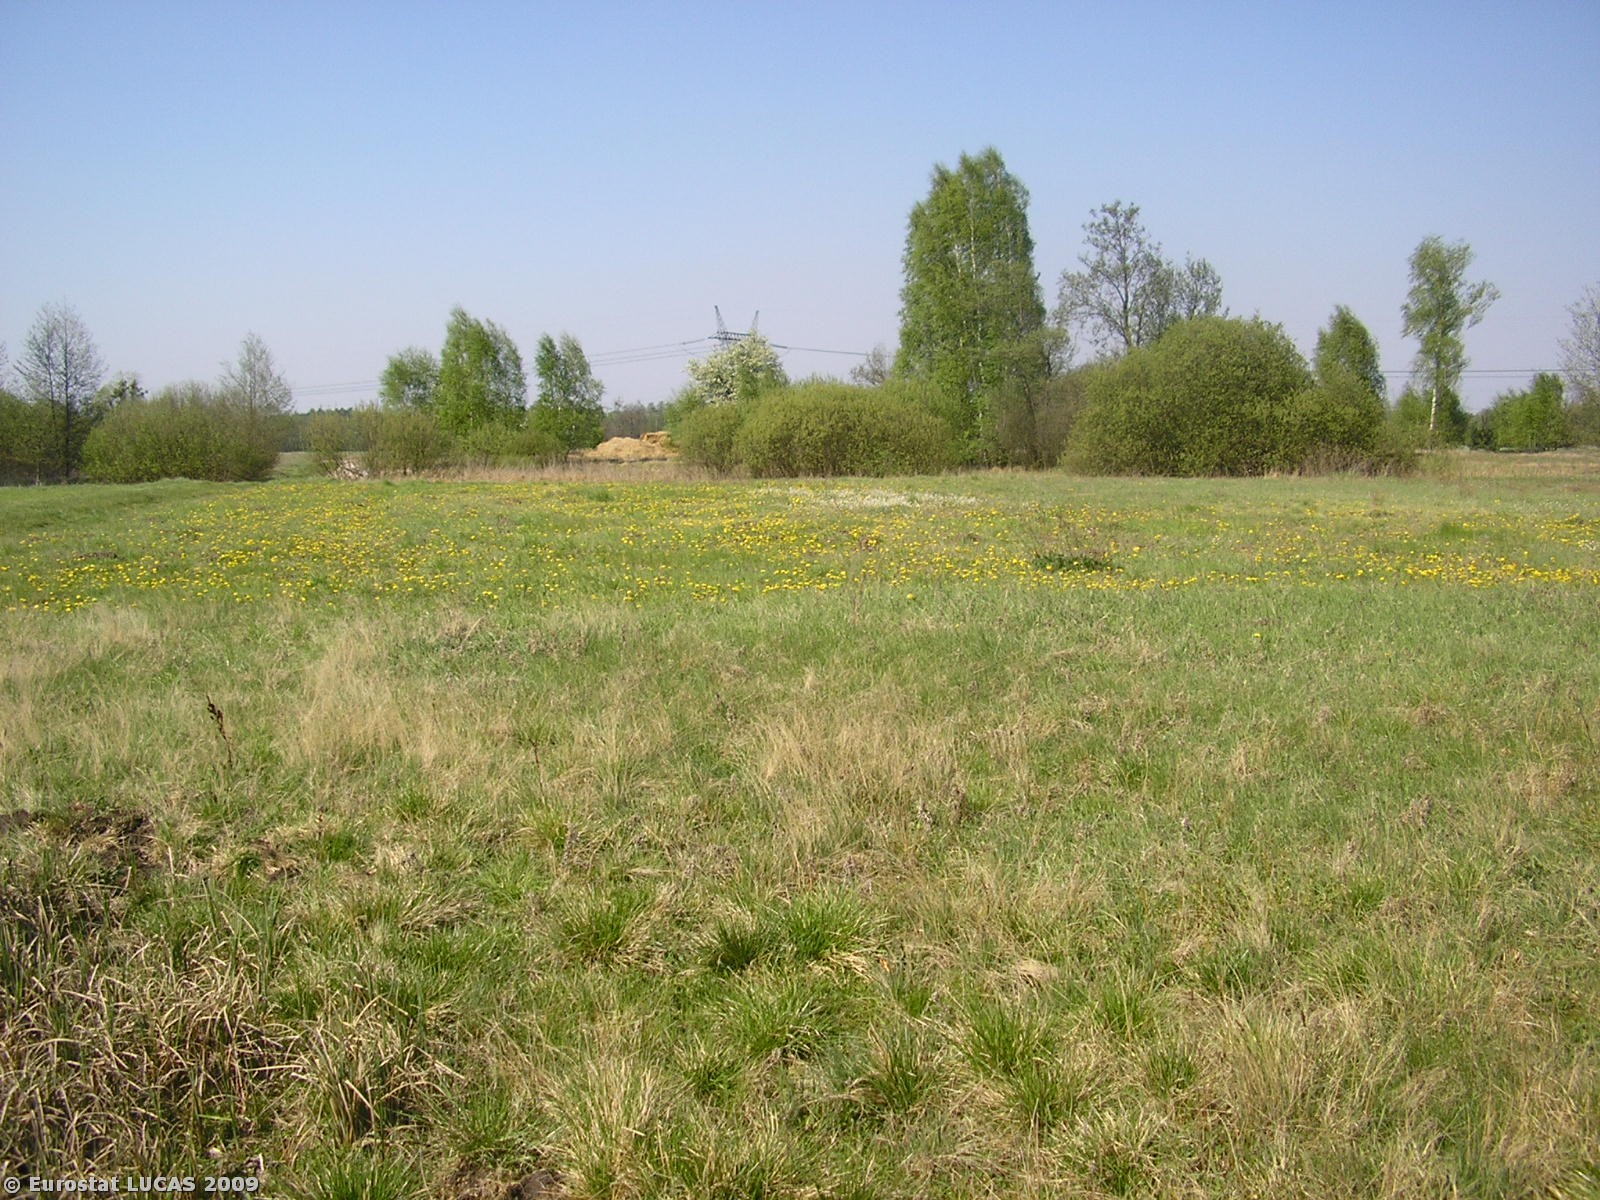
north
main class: Grassland
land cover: Grassland without tree/shrub cover
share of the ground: > 75 %
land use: Fallow land
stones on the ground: < 10 %
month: April
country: PL
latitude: 52.3353
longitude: 20.2052
